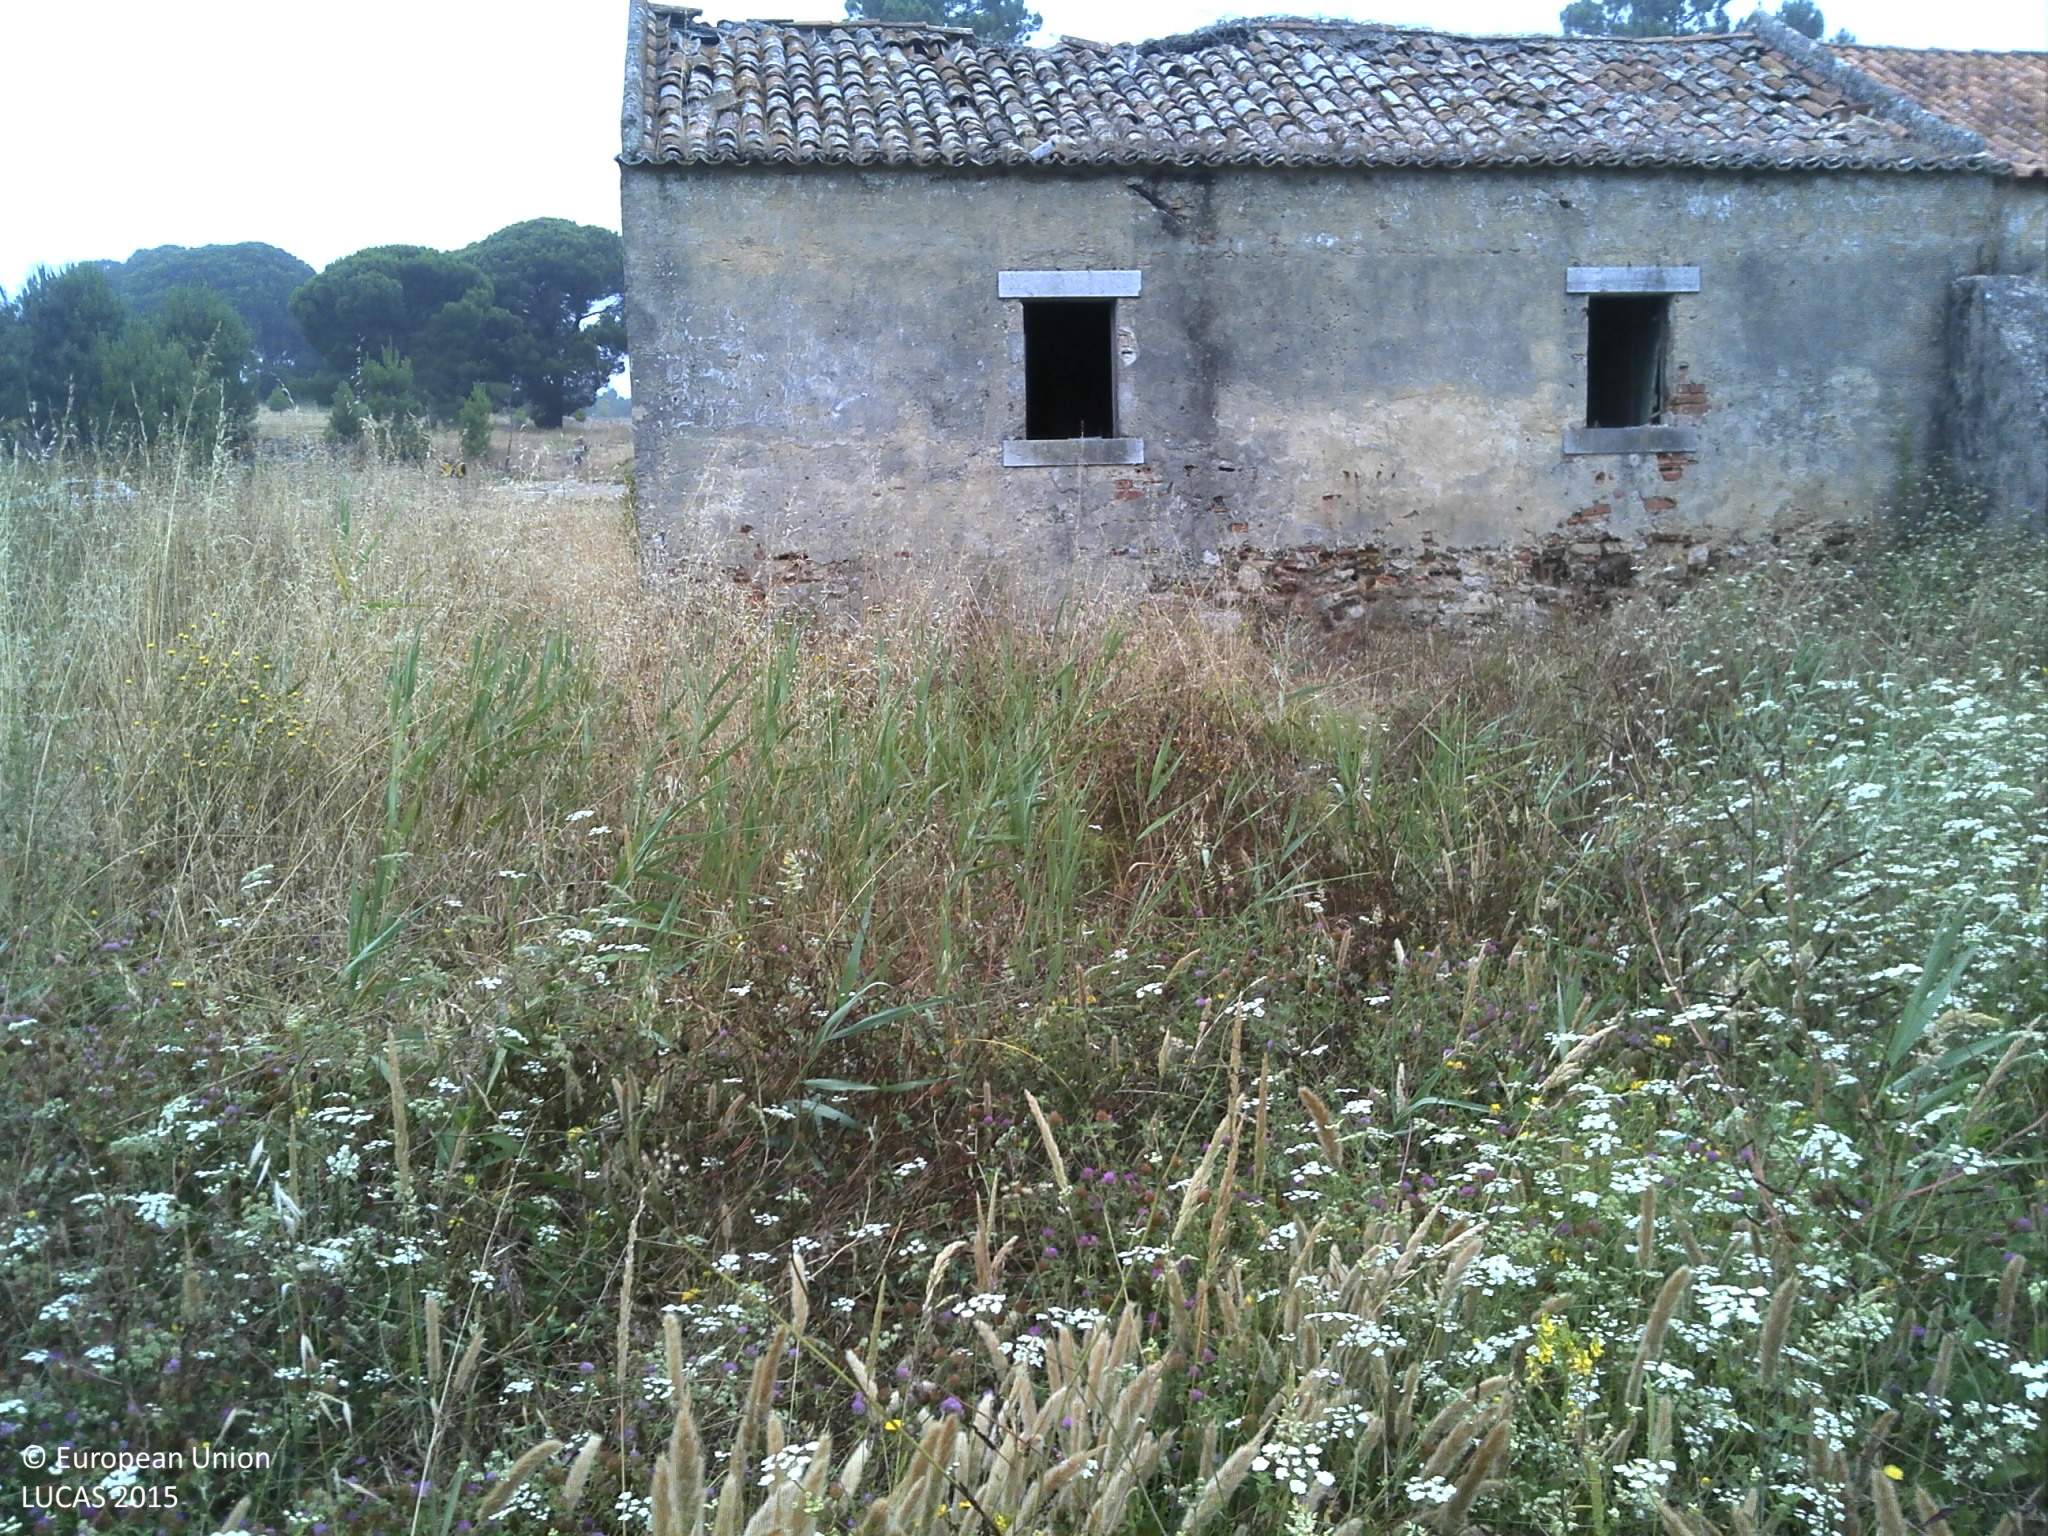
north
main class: Grassland
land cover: Spontaneously vegetated surfaces
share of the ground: > 75 %
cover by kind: herbaceous plants 95 %, unconsolidated bare surface 5 %
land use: Fallow land
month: June
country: PT
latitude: 38.5327
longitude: -9.1252
